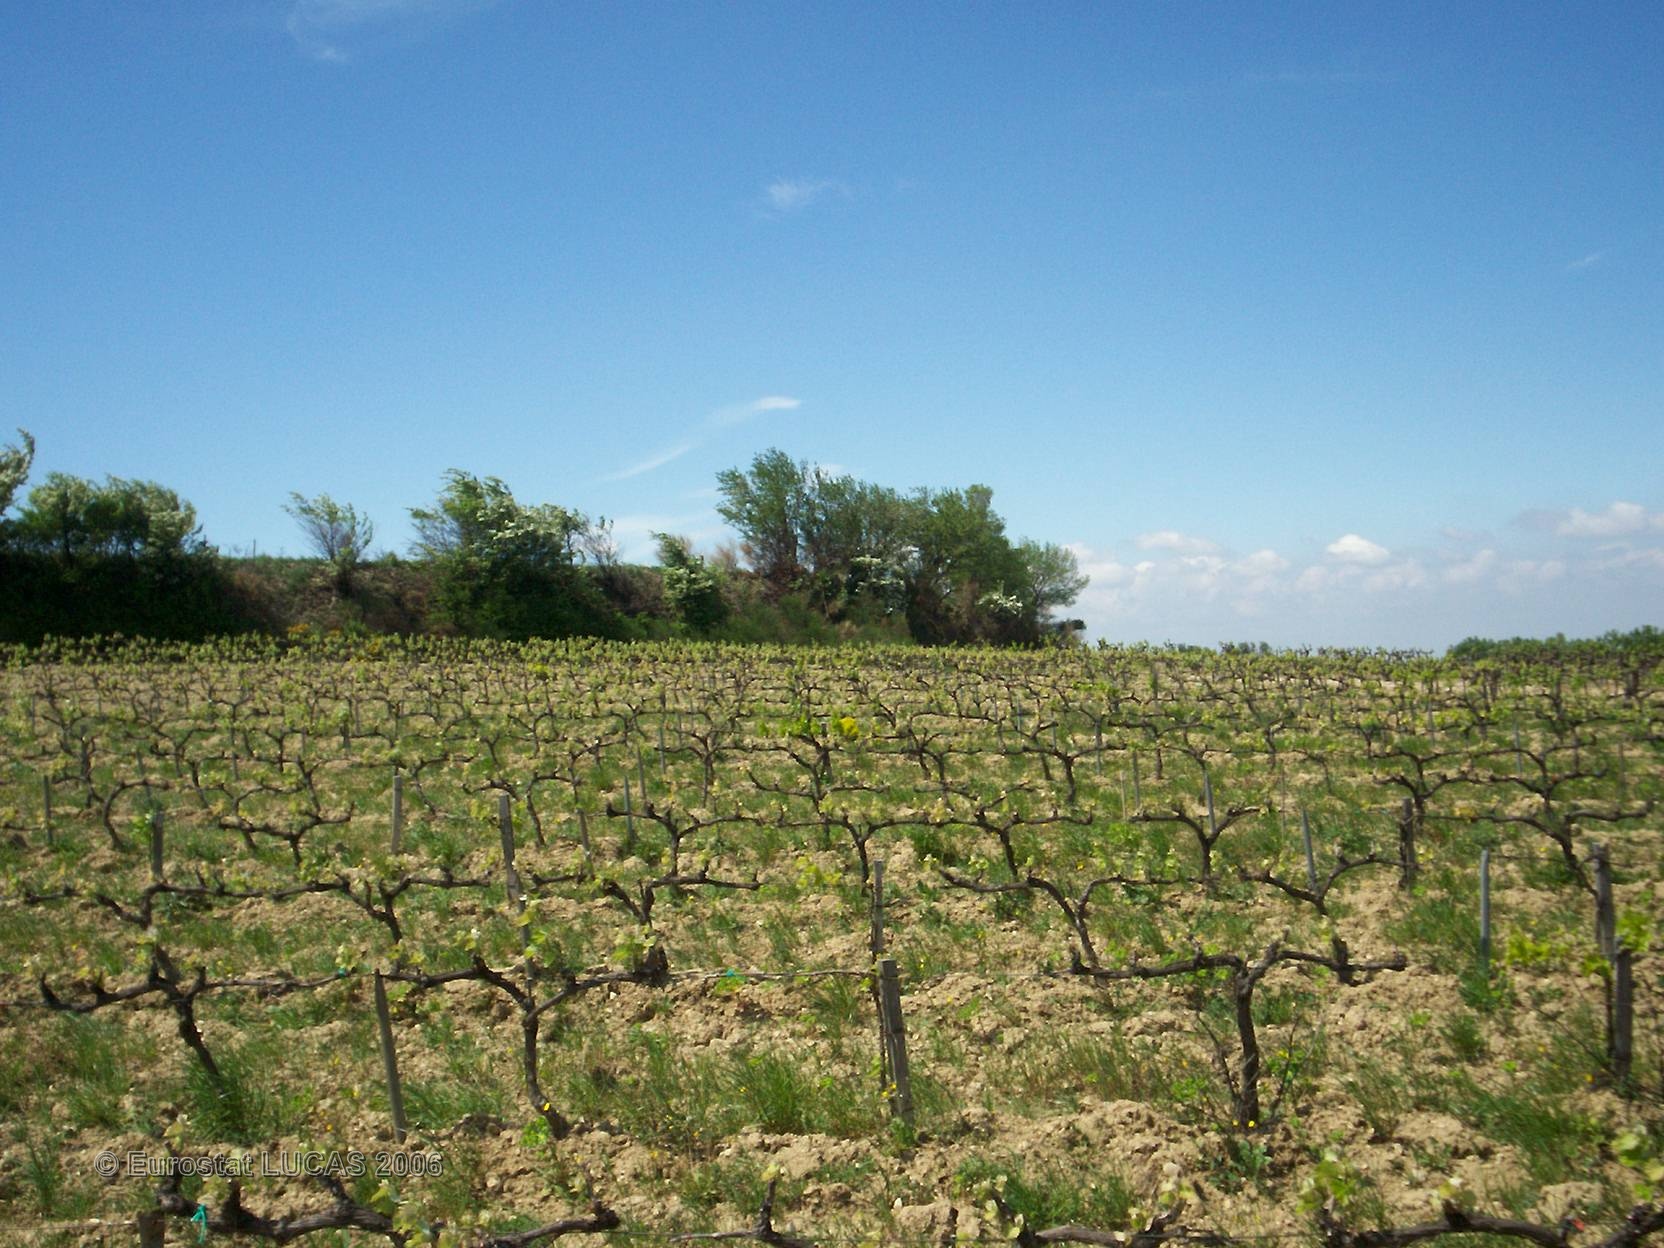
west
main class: Cropland
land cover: Vineyards
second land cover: Grassland with sparse tree/shrub cover
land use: Agriculture (excluding fallow land and kitchen gardens)
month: April
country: FR
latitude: 44.1563
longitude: 4.9690
